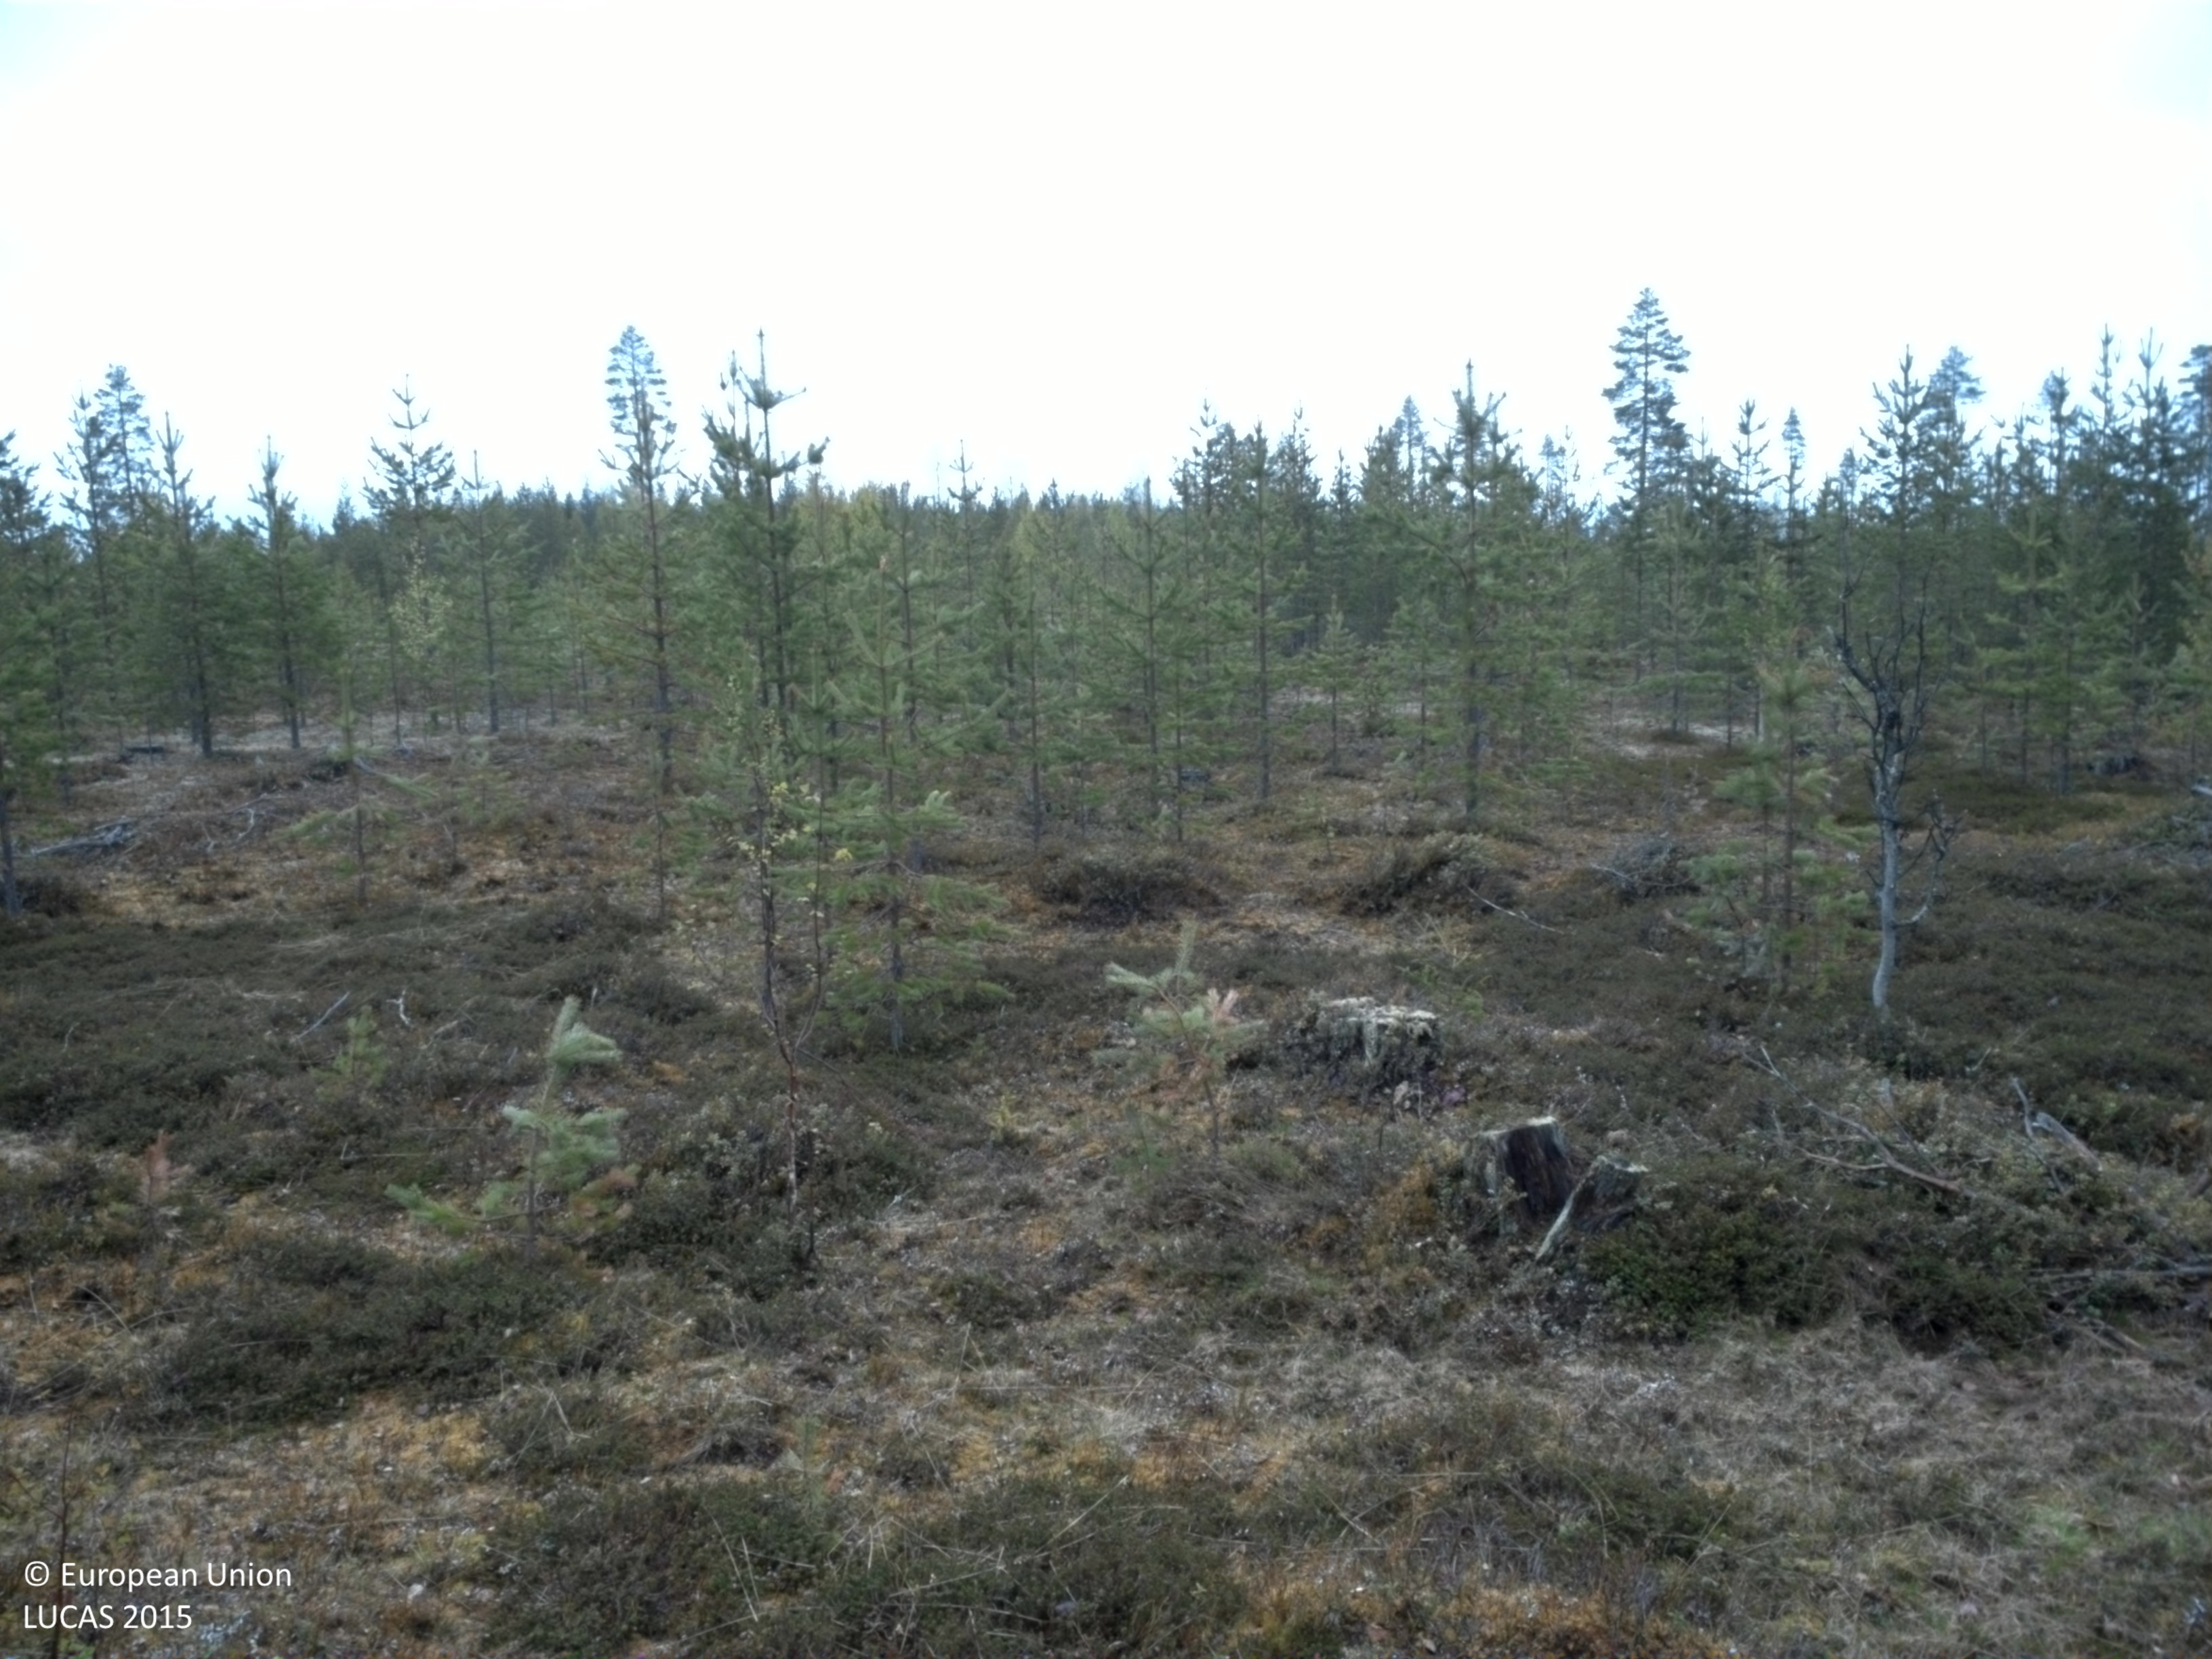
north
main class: Woodland
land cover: Pine dominated coniferous woodland
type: boreal forest
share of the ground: 25 - 50 %
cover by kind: shrubs 45 %, coniferous forest trees 40 %, broadleaved forest trees 5 %, herbaceous plants 5 %, lichens and mosses 5 %
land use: Forestry
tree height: < 5 m
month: June
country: SE
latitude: 65.9396
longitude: 23.1984
